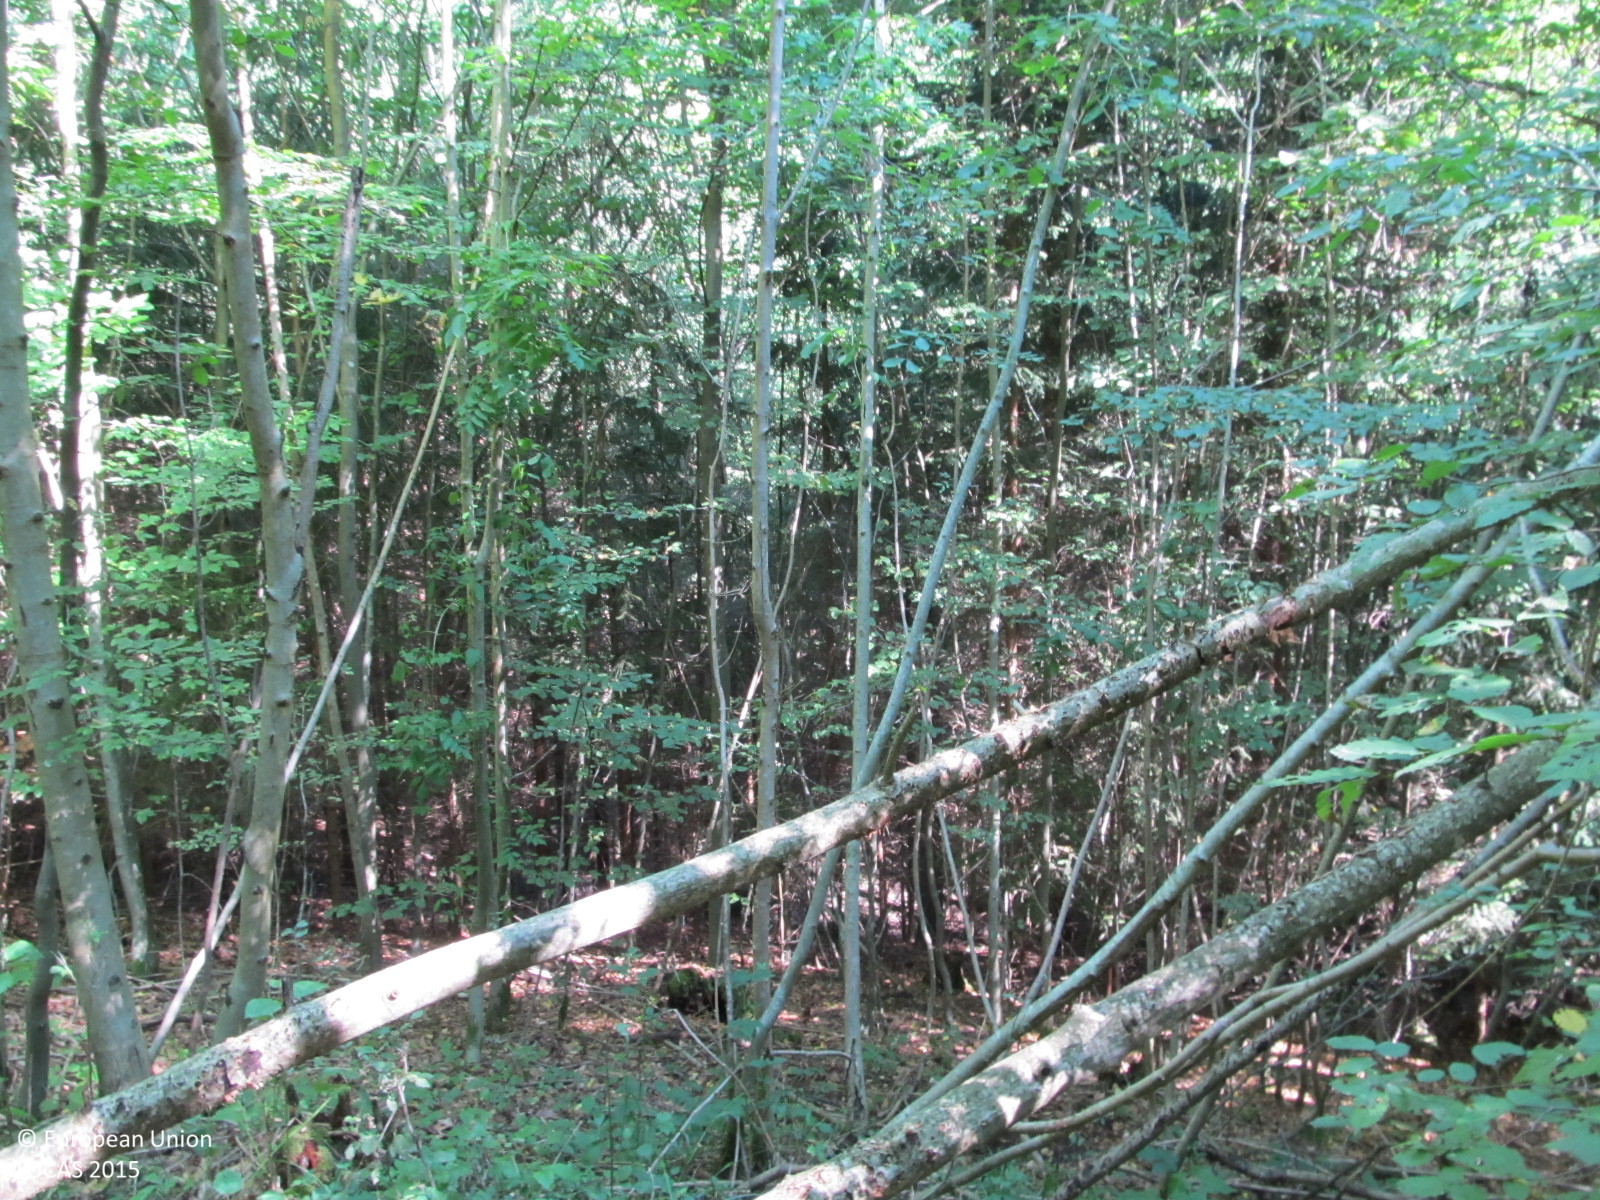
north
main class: Woodland
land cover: Other mixed woodland
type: hemiboreal forest and nemoral coniferous forest and mixed broadleaved-coniferous forest
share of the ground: > 75 %
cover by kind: broadleaved forest trees 55 %, coniferous forest trees 25 %, shrubs 10 %, unconsolidated bare surface 10 %
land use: Forestry
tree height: > 5 m
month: August
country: AT
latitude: 48.5655
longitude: 15.6541
